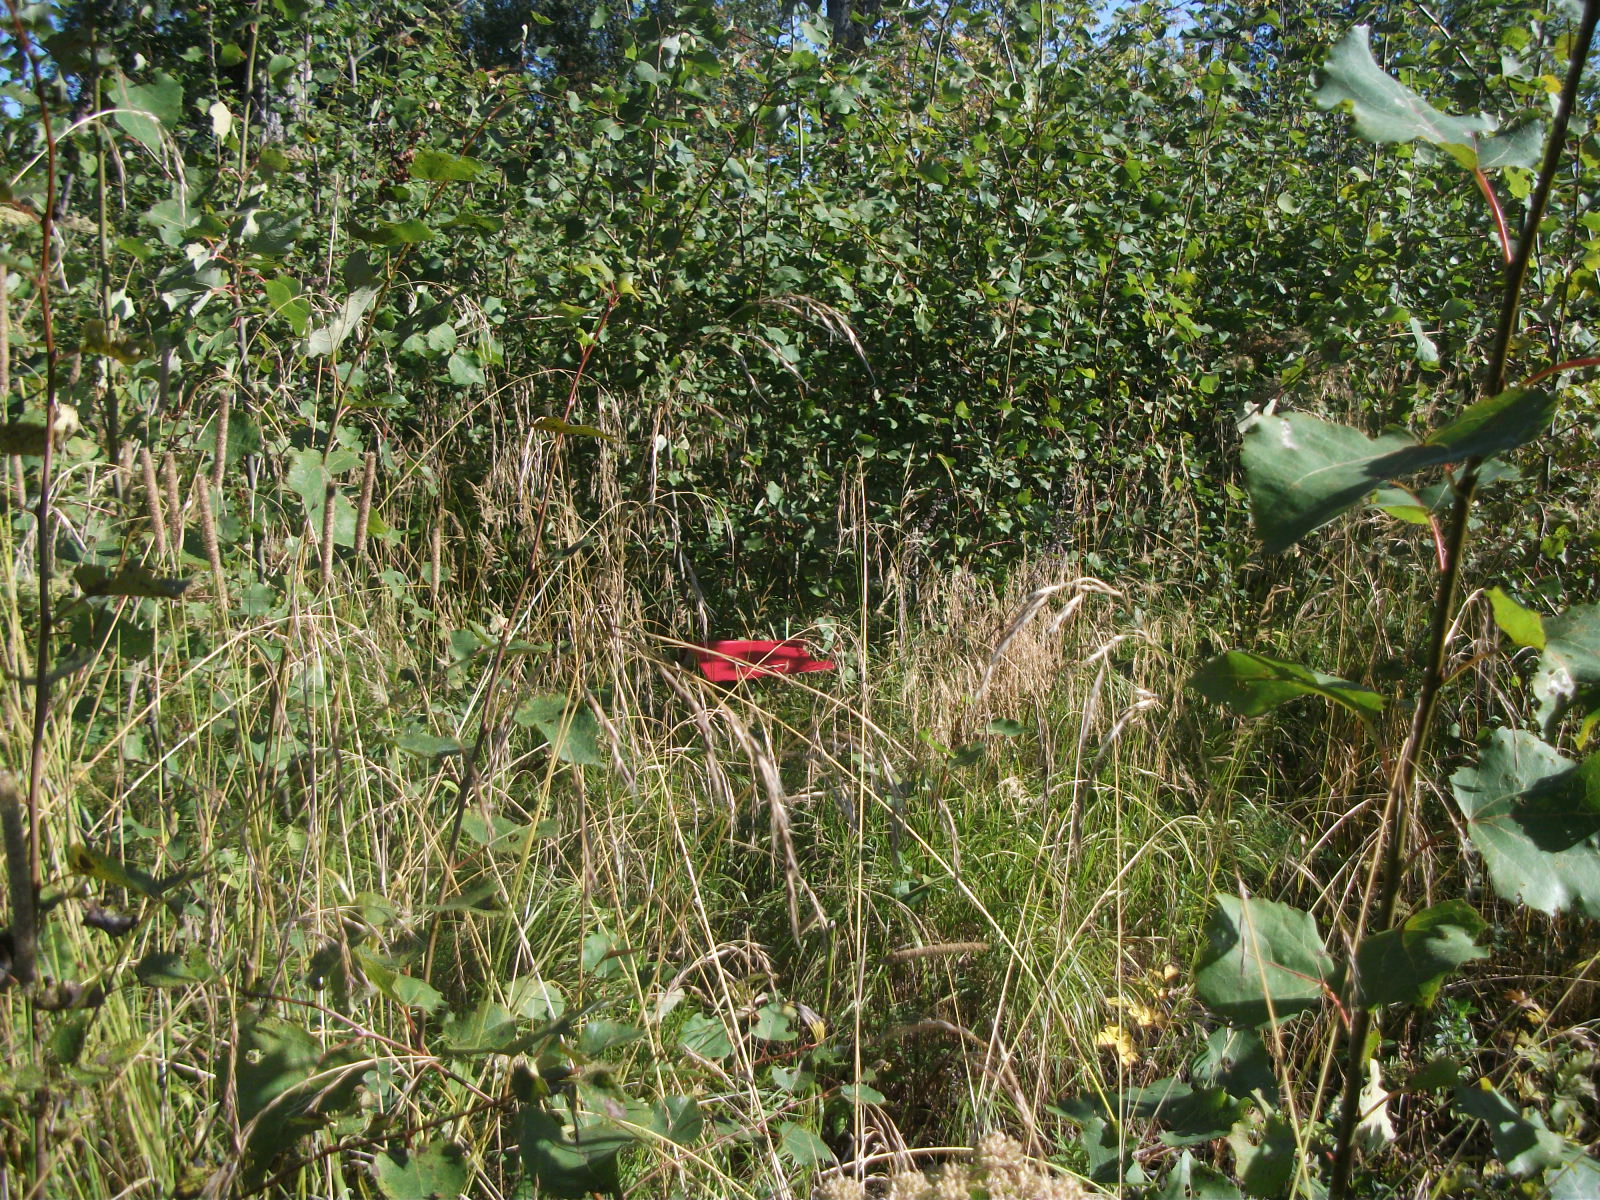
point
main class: Woodland
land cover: Broadleaved woodland
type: non-riverine alder, birch or aspen forest
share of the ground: > 75 %
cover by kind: broadleaved forest trees 80 %, shrubs 10 %, herbaceous plants 10 %
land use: Forestry
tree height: < 5 m
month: August
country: LV
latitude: 56.2874
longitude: 26.3479
